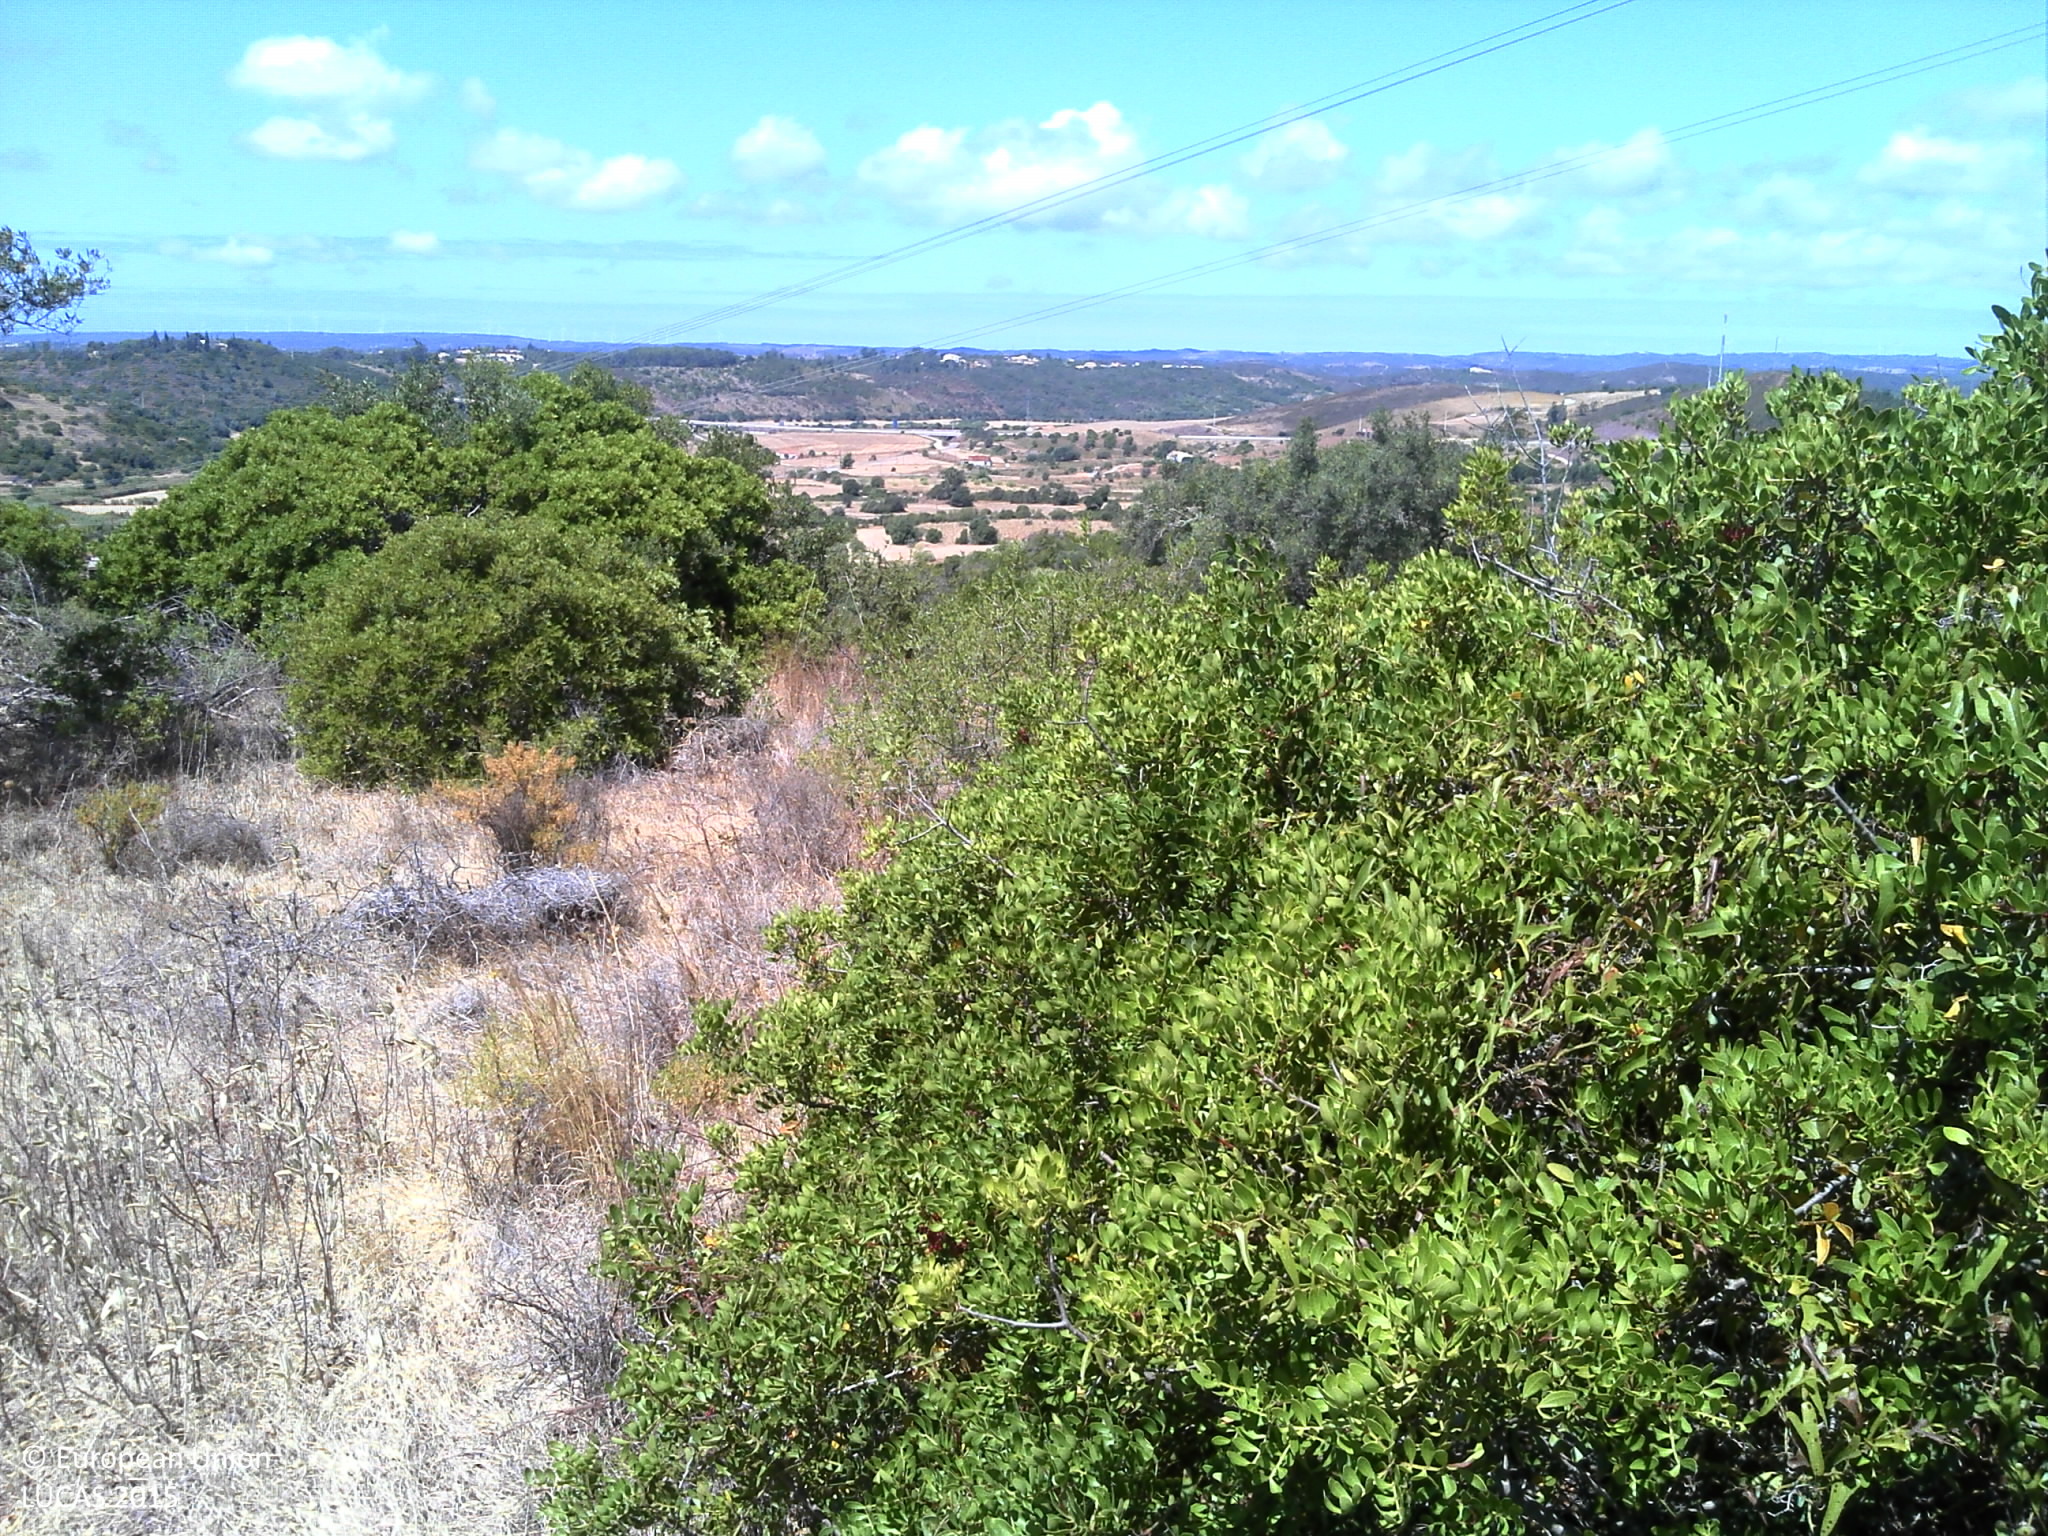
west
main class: Cropland
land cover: Olive groves
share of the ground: 25 - 50 %
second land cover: Grassland without tree/shrub cover
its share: 25 - 50 %
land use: Abandoned areas
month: July
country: PT
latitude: 37.1611
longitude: -8.6658
